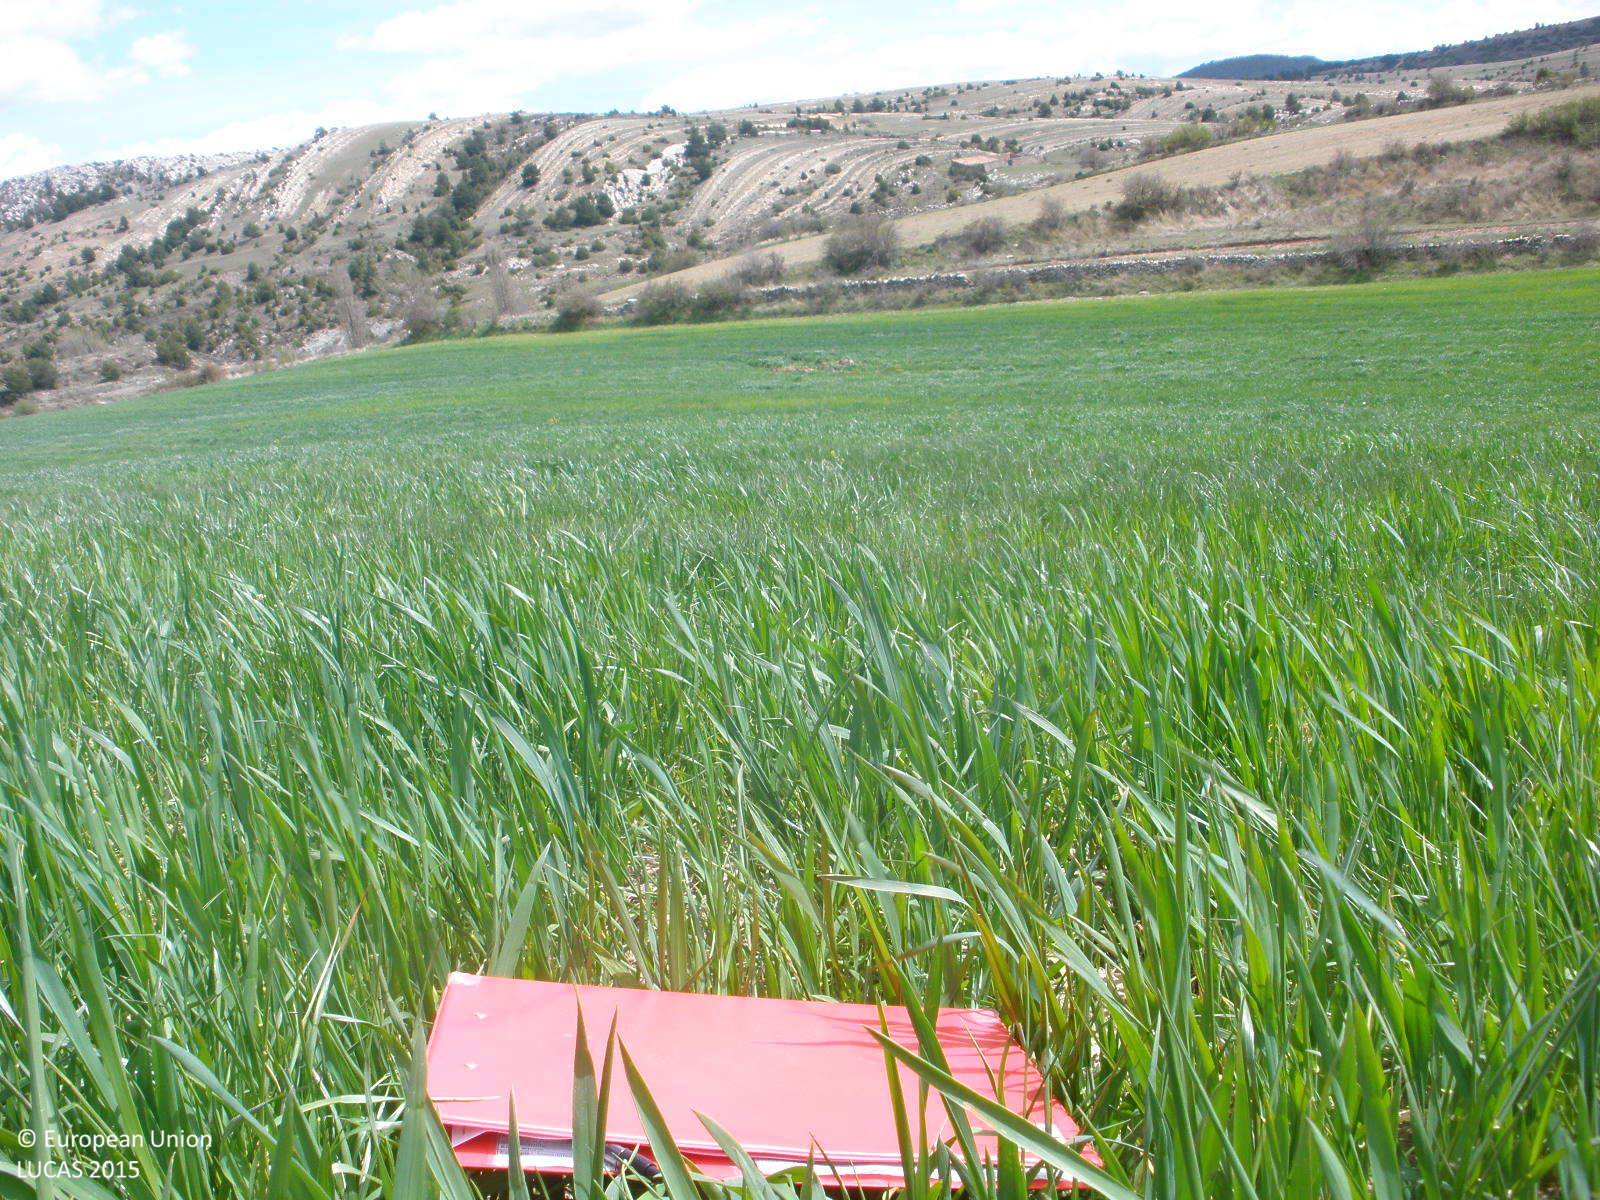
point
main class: Cropland
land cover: Barley
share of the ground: > 75 %
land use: Agriculture (excluding fallow land and kitchen gardens)
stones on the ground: 10 - 25 %
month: April
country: ES
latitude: 40.4510
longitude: -0.8223
